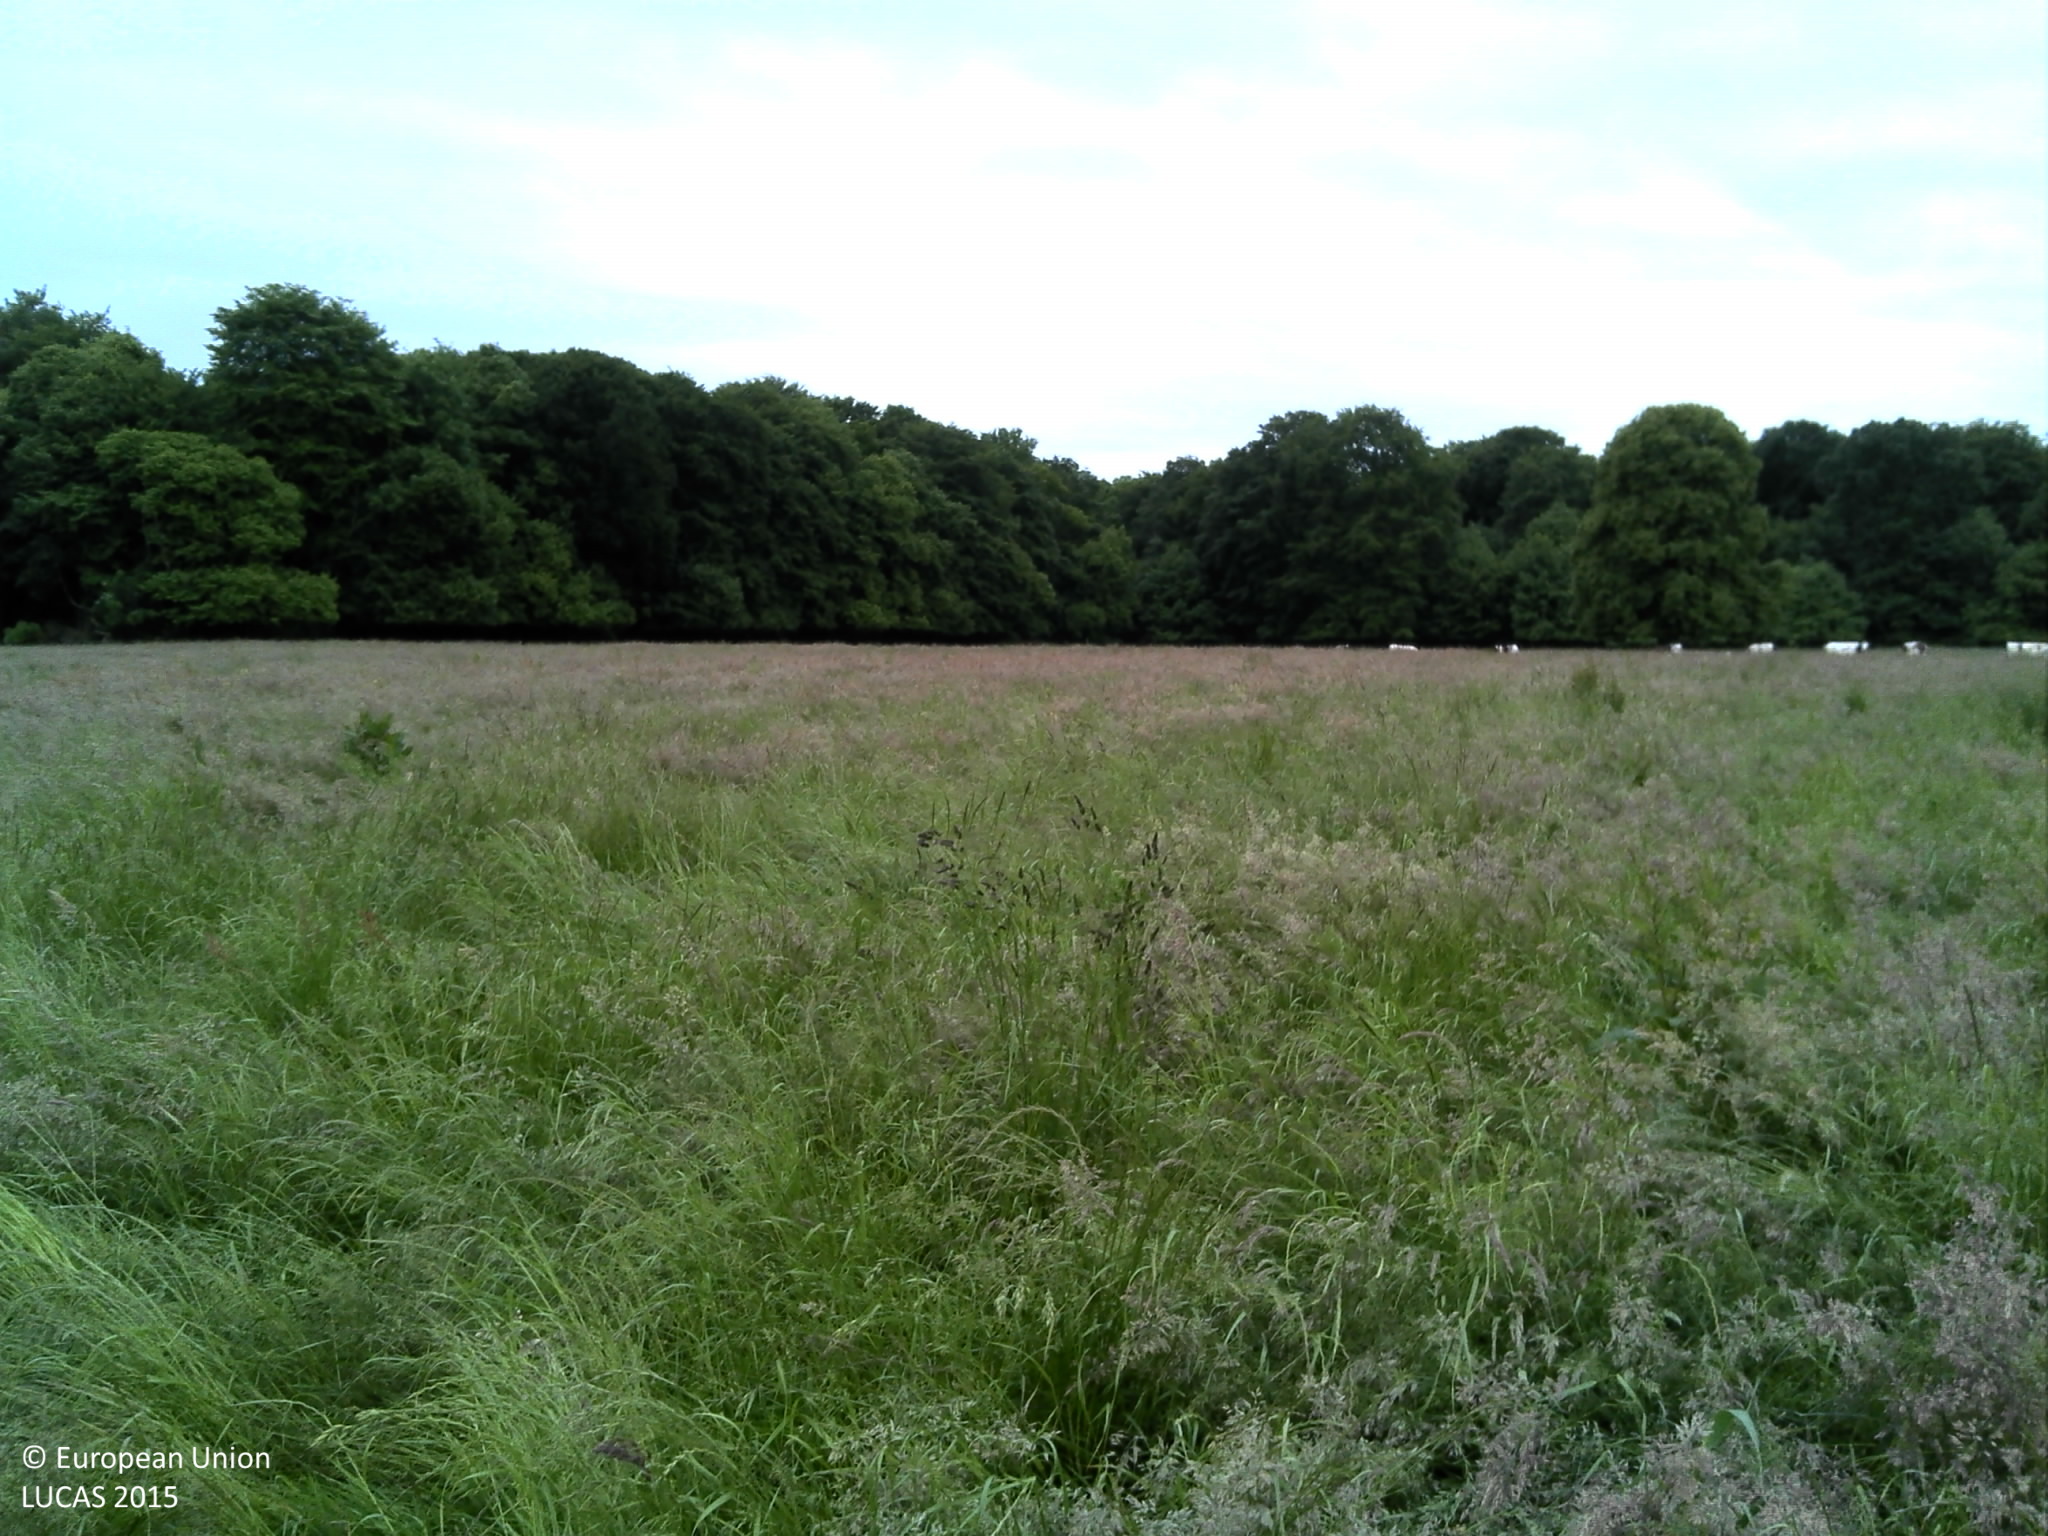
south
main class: Grassland
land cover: Grassland without tree/shrub cover
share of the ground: > 75 %
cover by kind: herbaceous plants 100 %
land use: Agriculture (excluding fallow land and kitchen gardens)
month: June
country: FR
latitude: 49.4832
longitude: 0.9917
